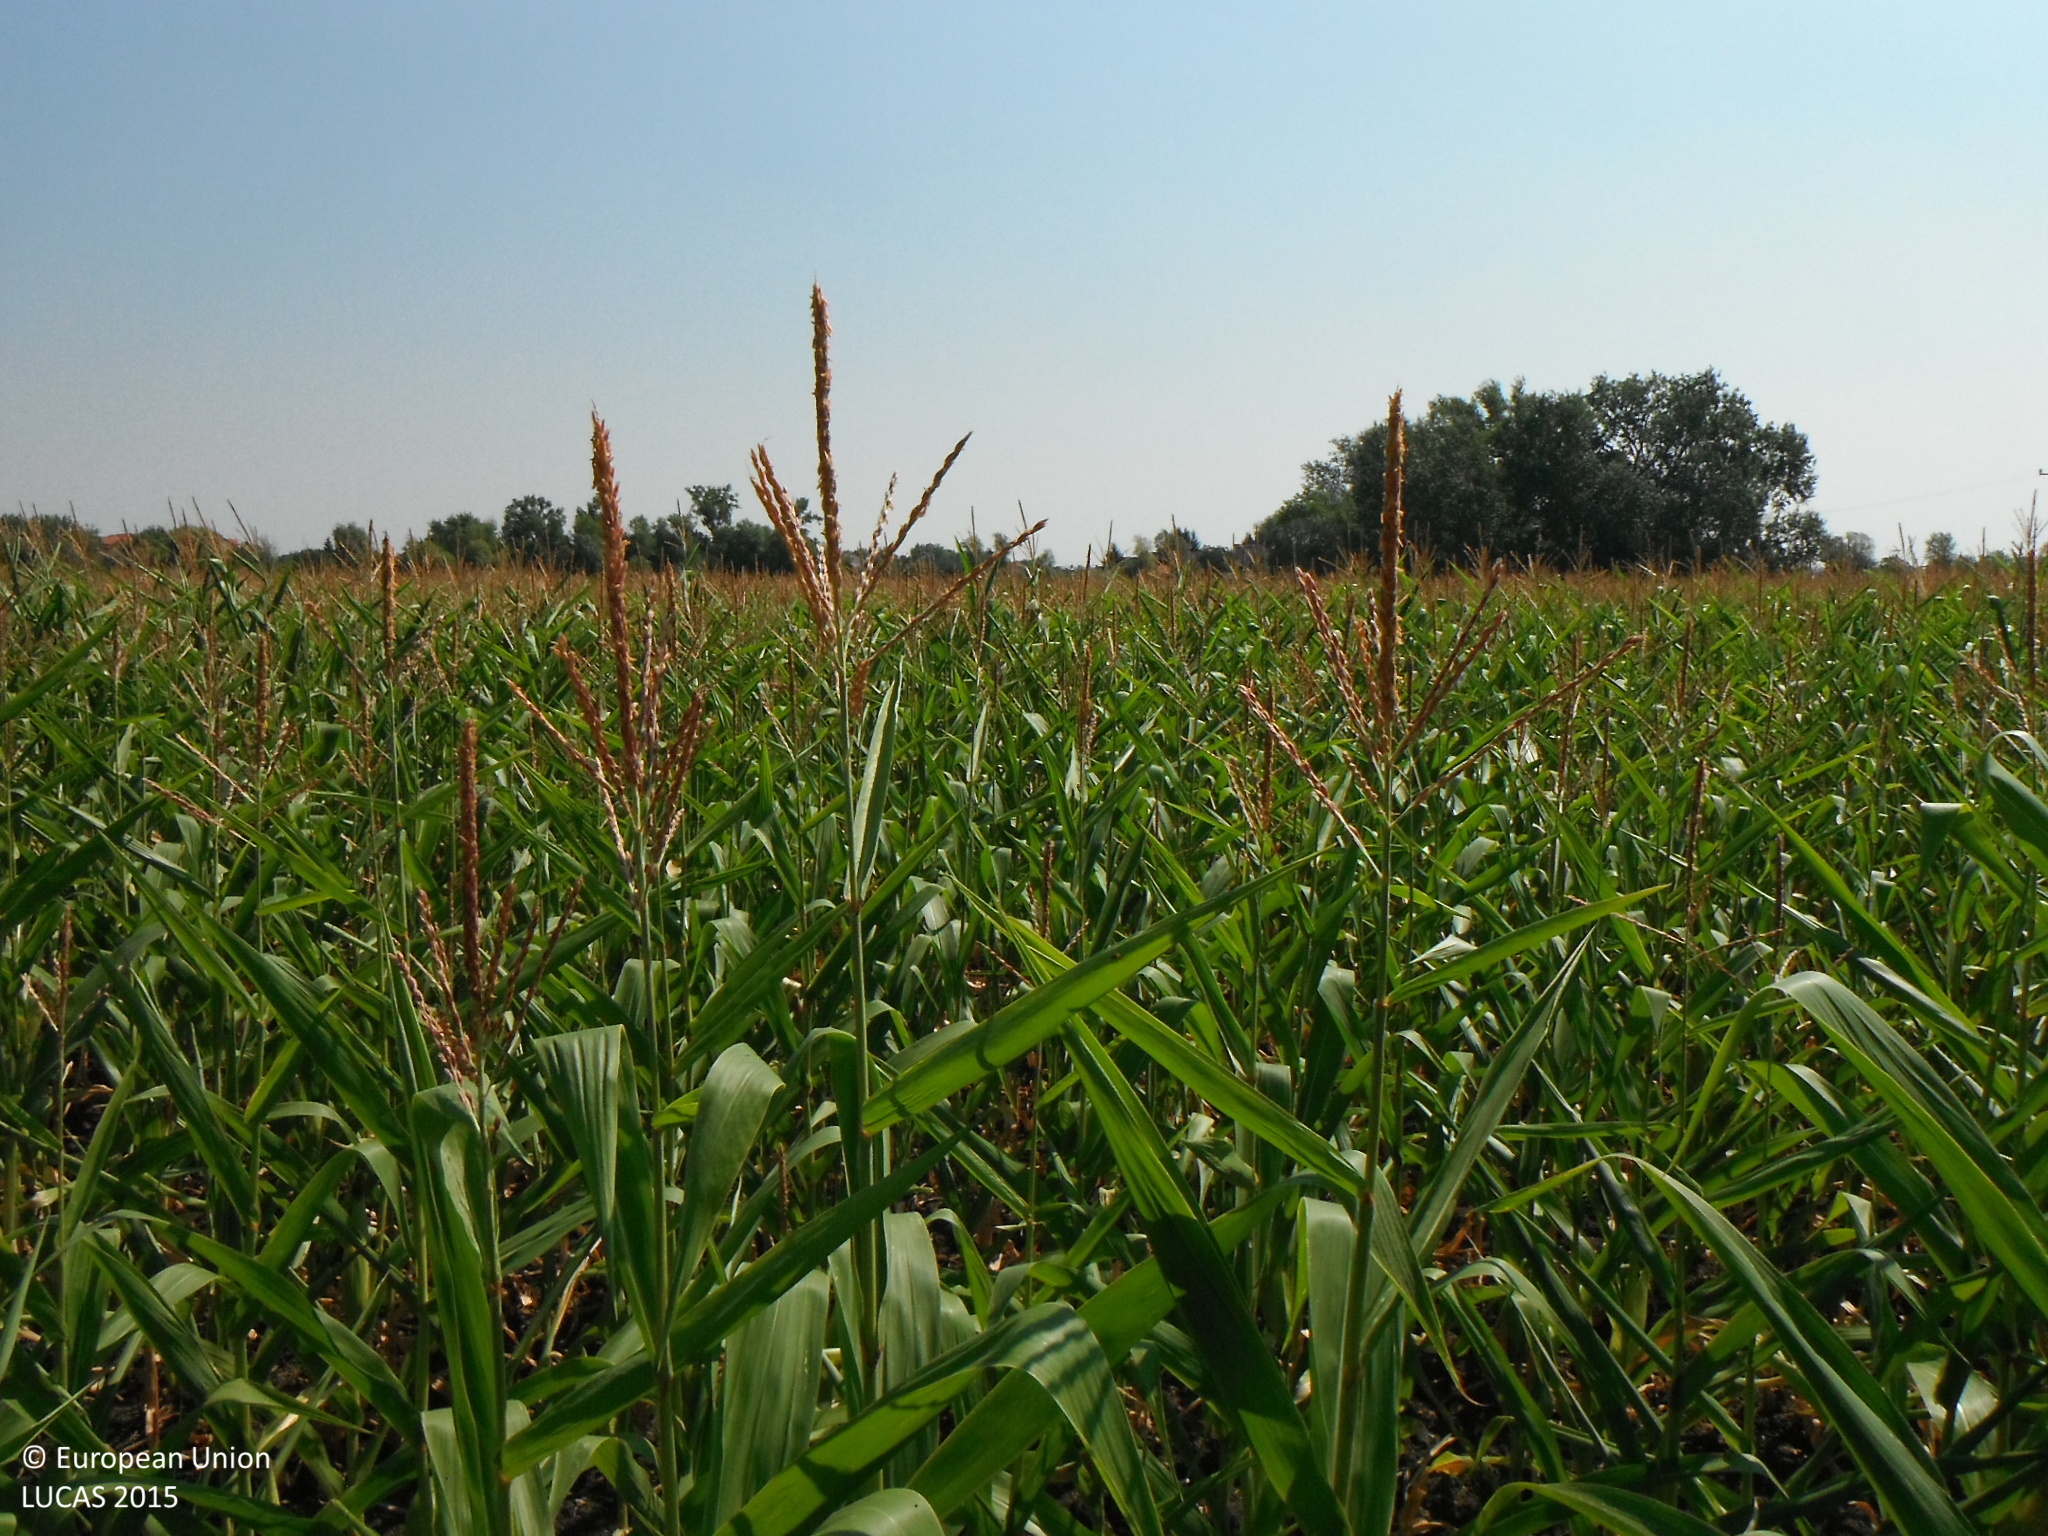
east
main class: Cropland
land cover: Maize
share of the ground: > 75 %
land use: Agriculture (excluding fallow land and kitchen gardens)
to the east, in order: Maize; Broadleaved woodland; Inland fresh running water; Broadleaved woodland; Spontaneously vegetated surfaces
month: August
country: SK
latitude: 48.0773
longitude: 18.2421
